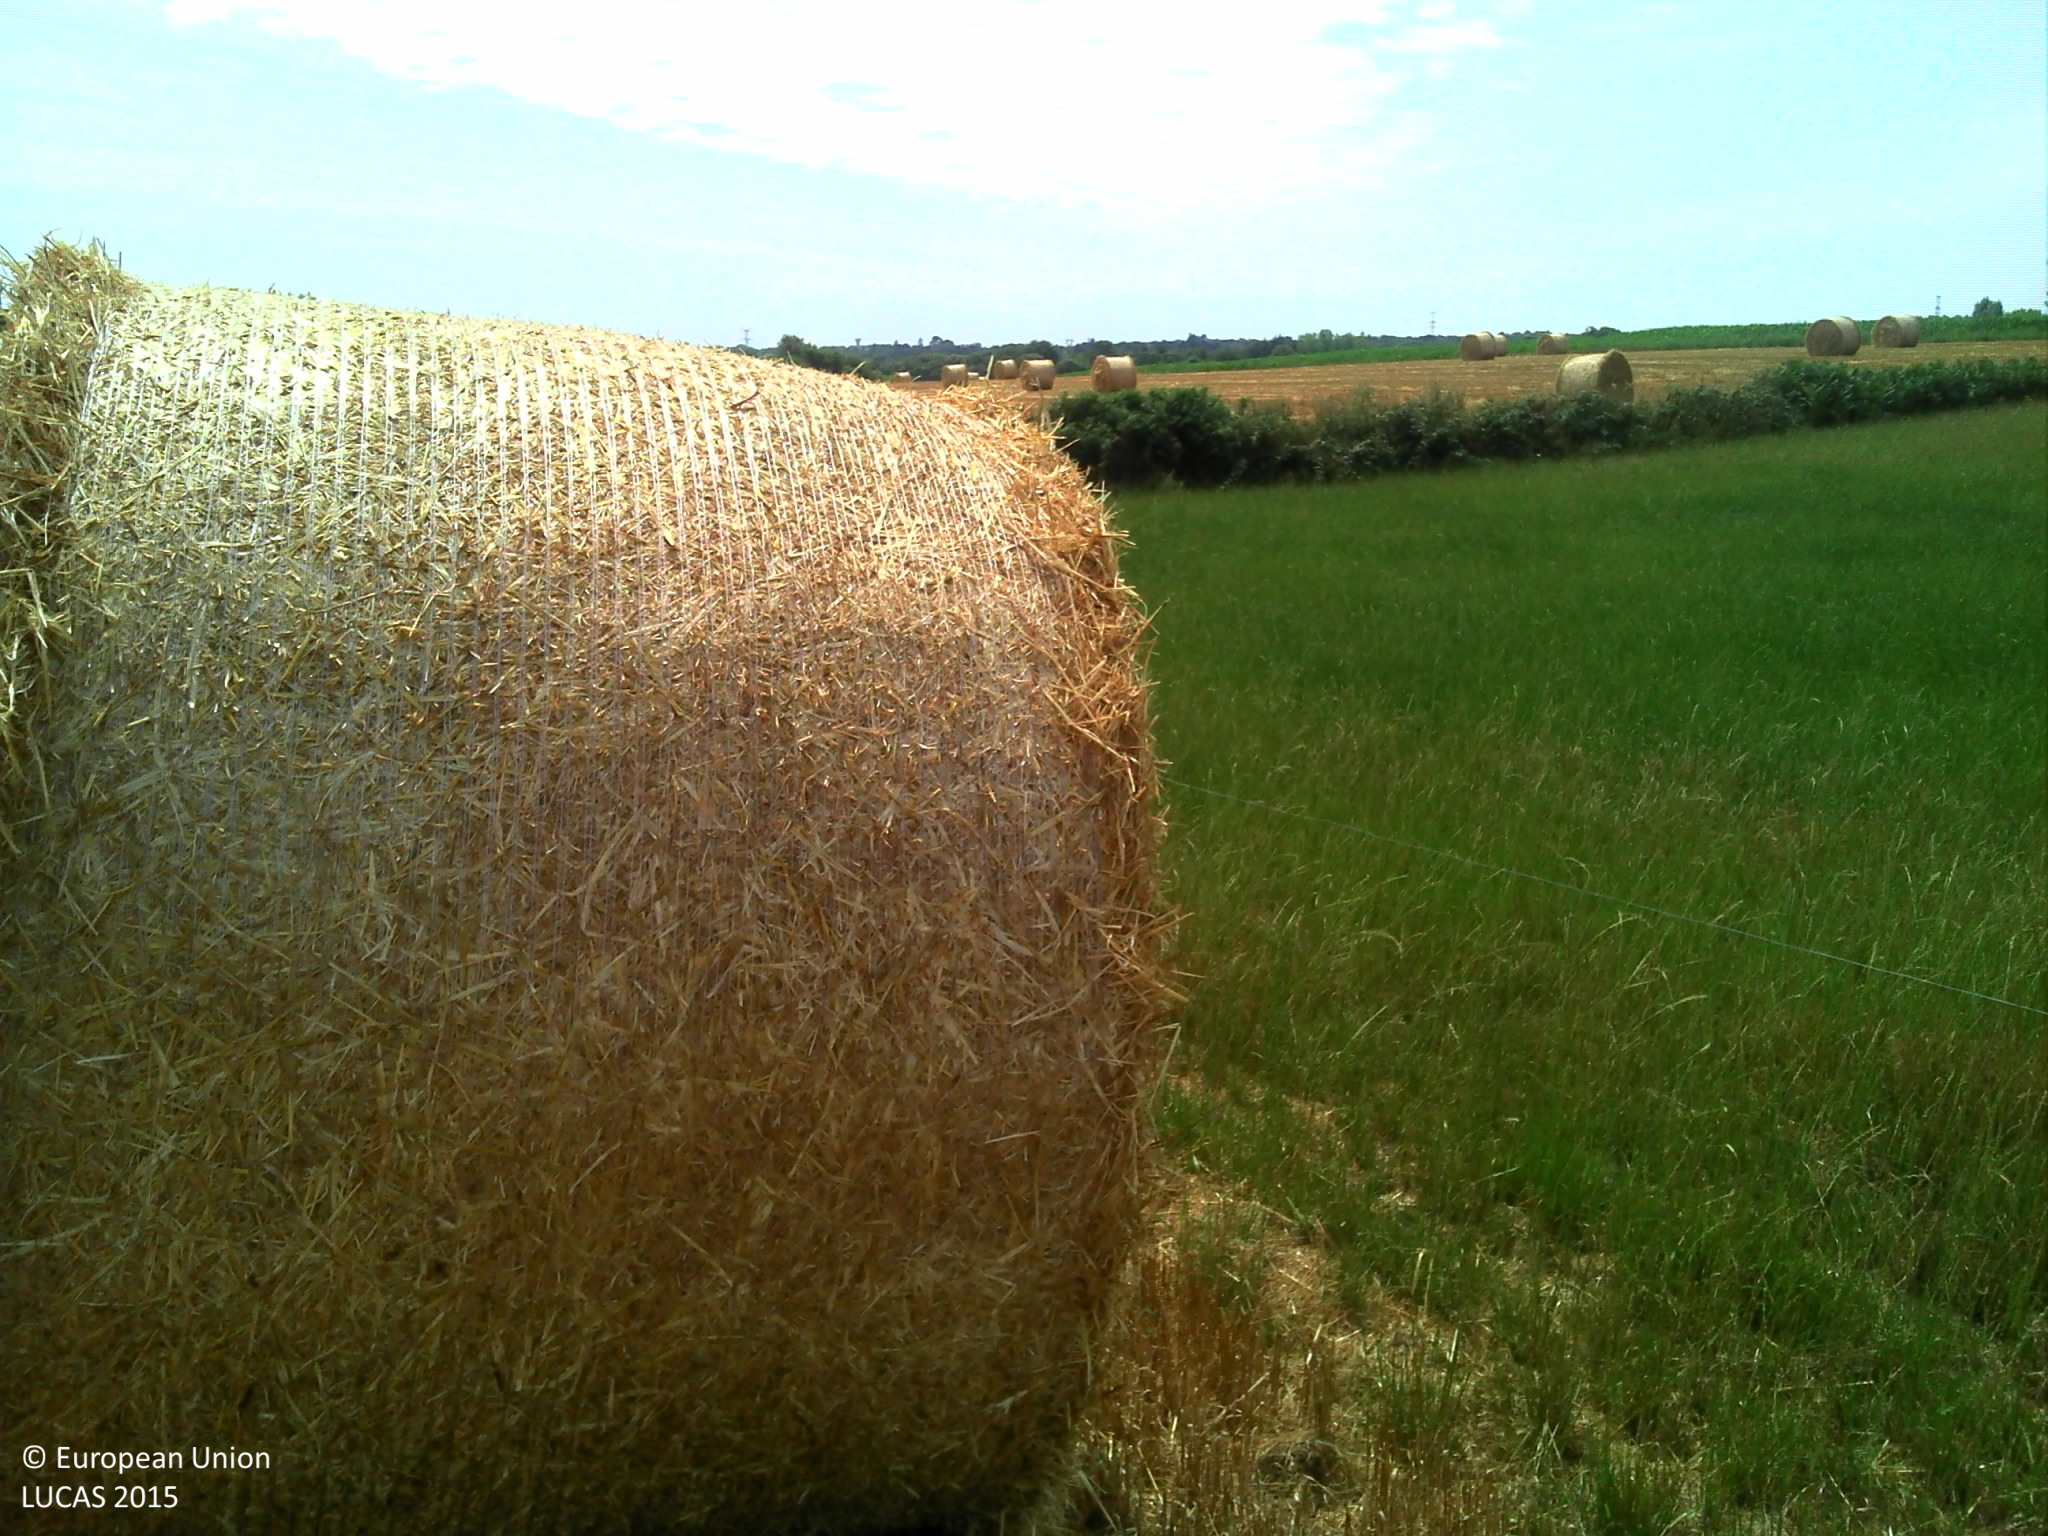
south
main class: Cropland
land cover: Barley
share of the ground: > 75 %
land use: Agriculture (excluding fallow land and kitchen gardens)
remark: Harvested field
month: July
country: FR
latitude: 47.9052
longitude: -3.3035
